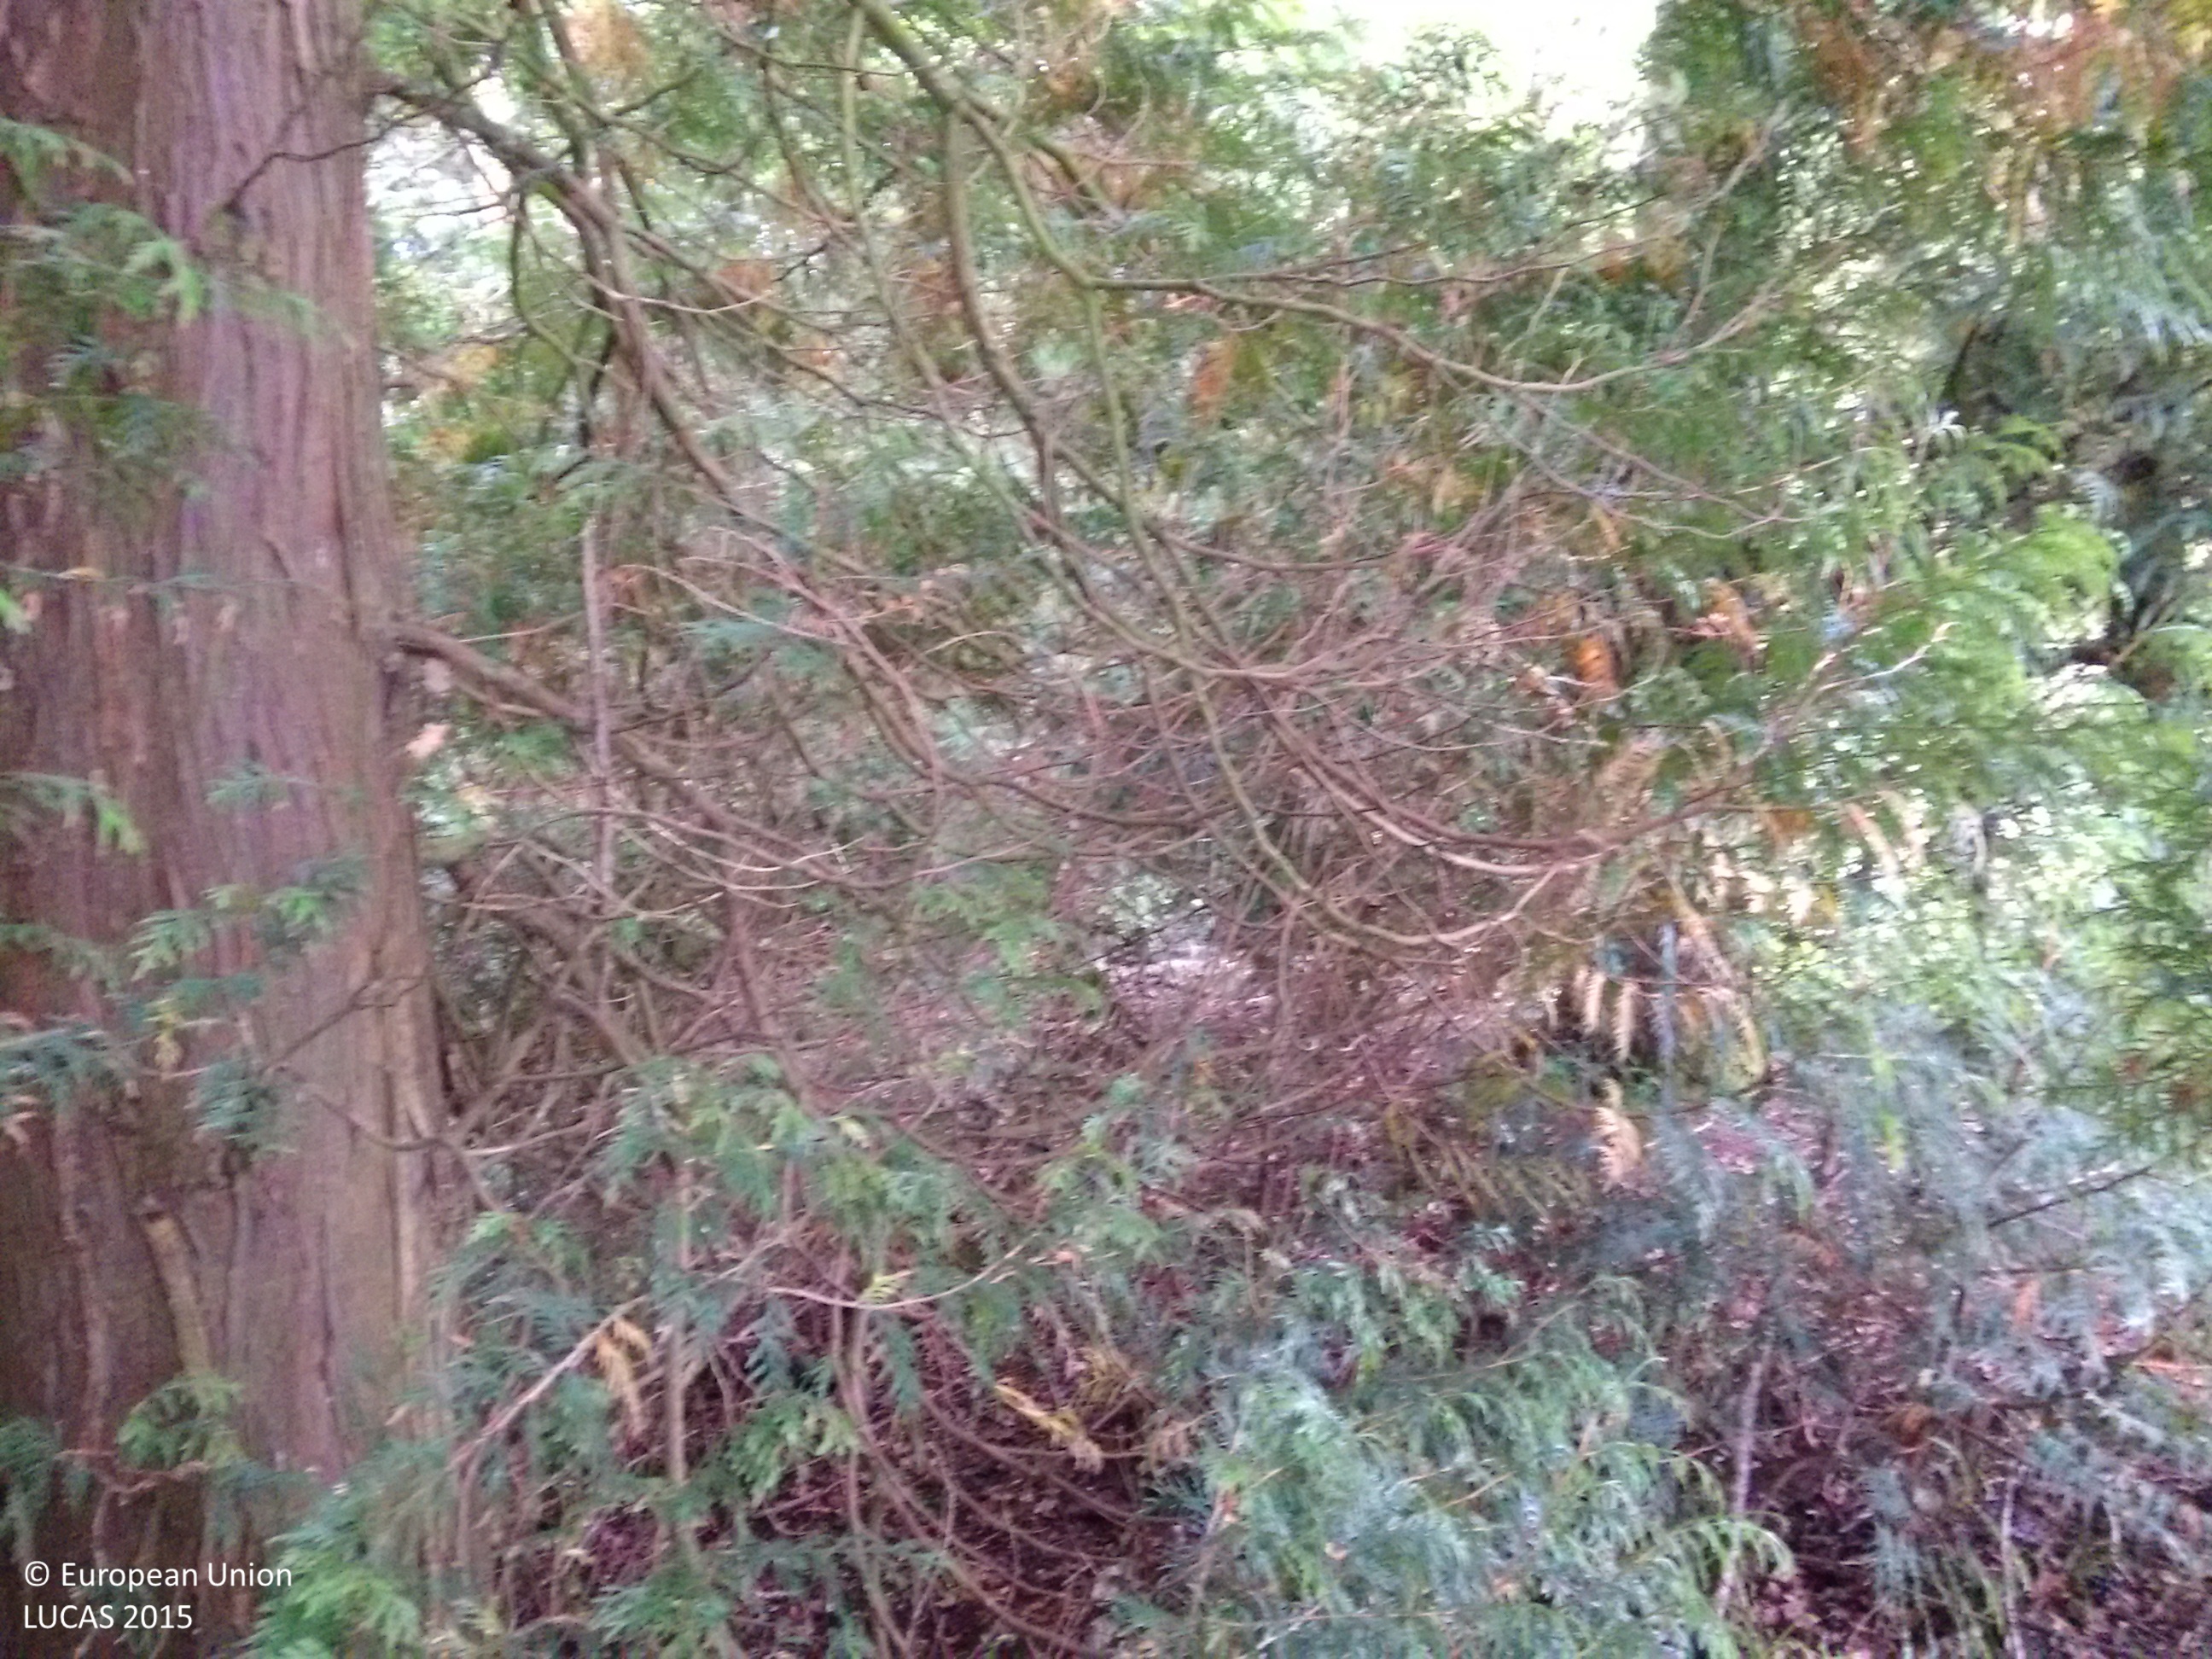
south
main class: Woodland
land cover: Other mixed woodland
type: exotic forest
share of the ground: > 75 %
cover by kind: coniferous forest trees 75 %, broadleaved forest trees 25 %
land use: Semi-natural and natural areas not in use
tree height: > 5 m
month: September
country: GB
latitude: 52.9723
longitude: -2.9850
